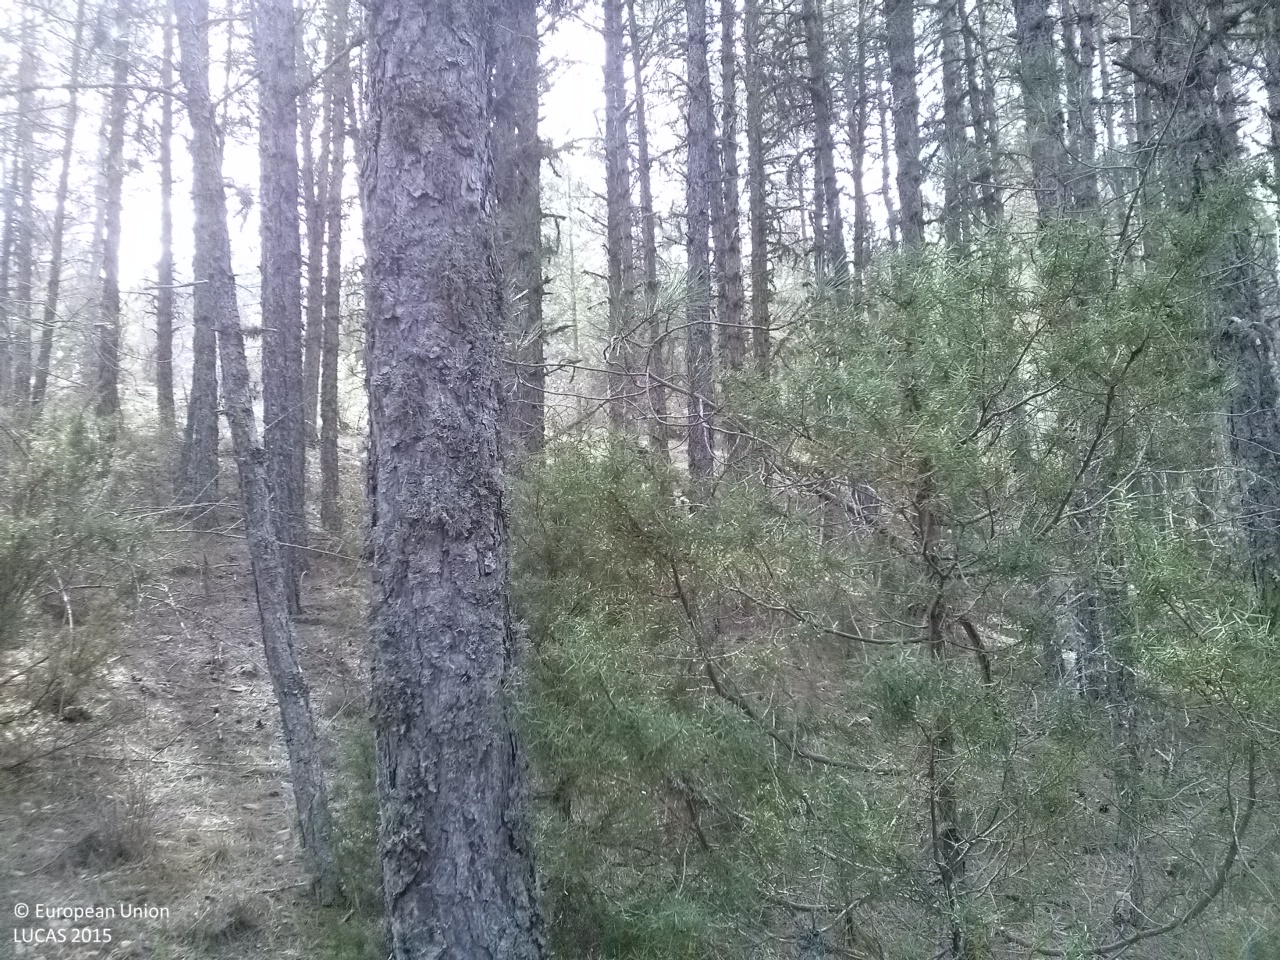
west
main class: Woodland
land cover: Pine dominated coniferous woodland
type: coniferous forest of the mediterranean region
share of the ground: > 75 %
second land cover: Grassland without tree/shrub cover
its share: 10 - 25 %
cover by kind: coniferous forest trees 85 %, herbaceous plants 10 %, shrubs 5 %
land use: Forestry
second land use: Agriculture (excluding fallow land and kitchen gardens)
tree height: > 5 m
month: April
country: ES
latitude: 40.1190
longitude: -1.9478
